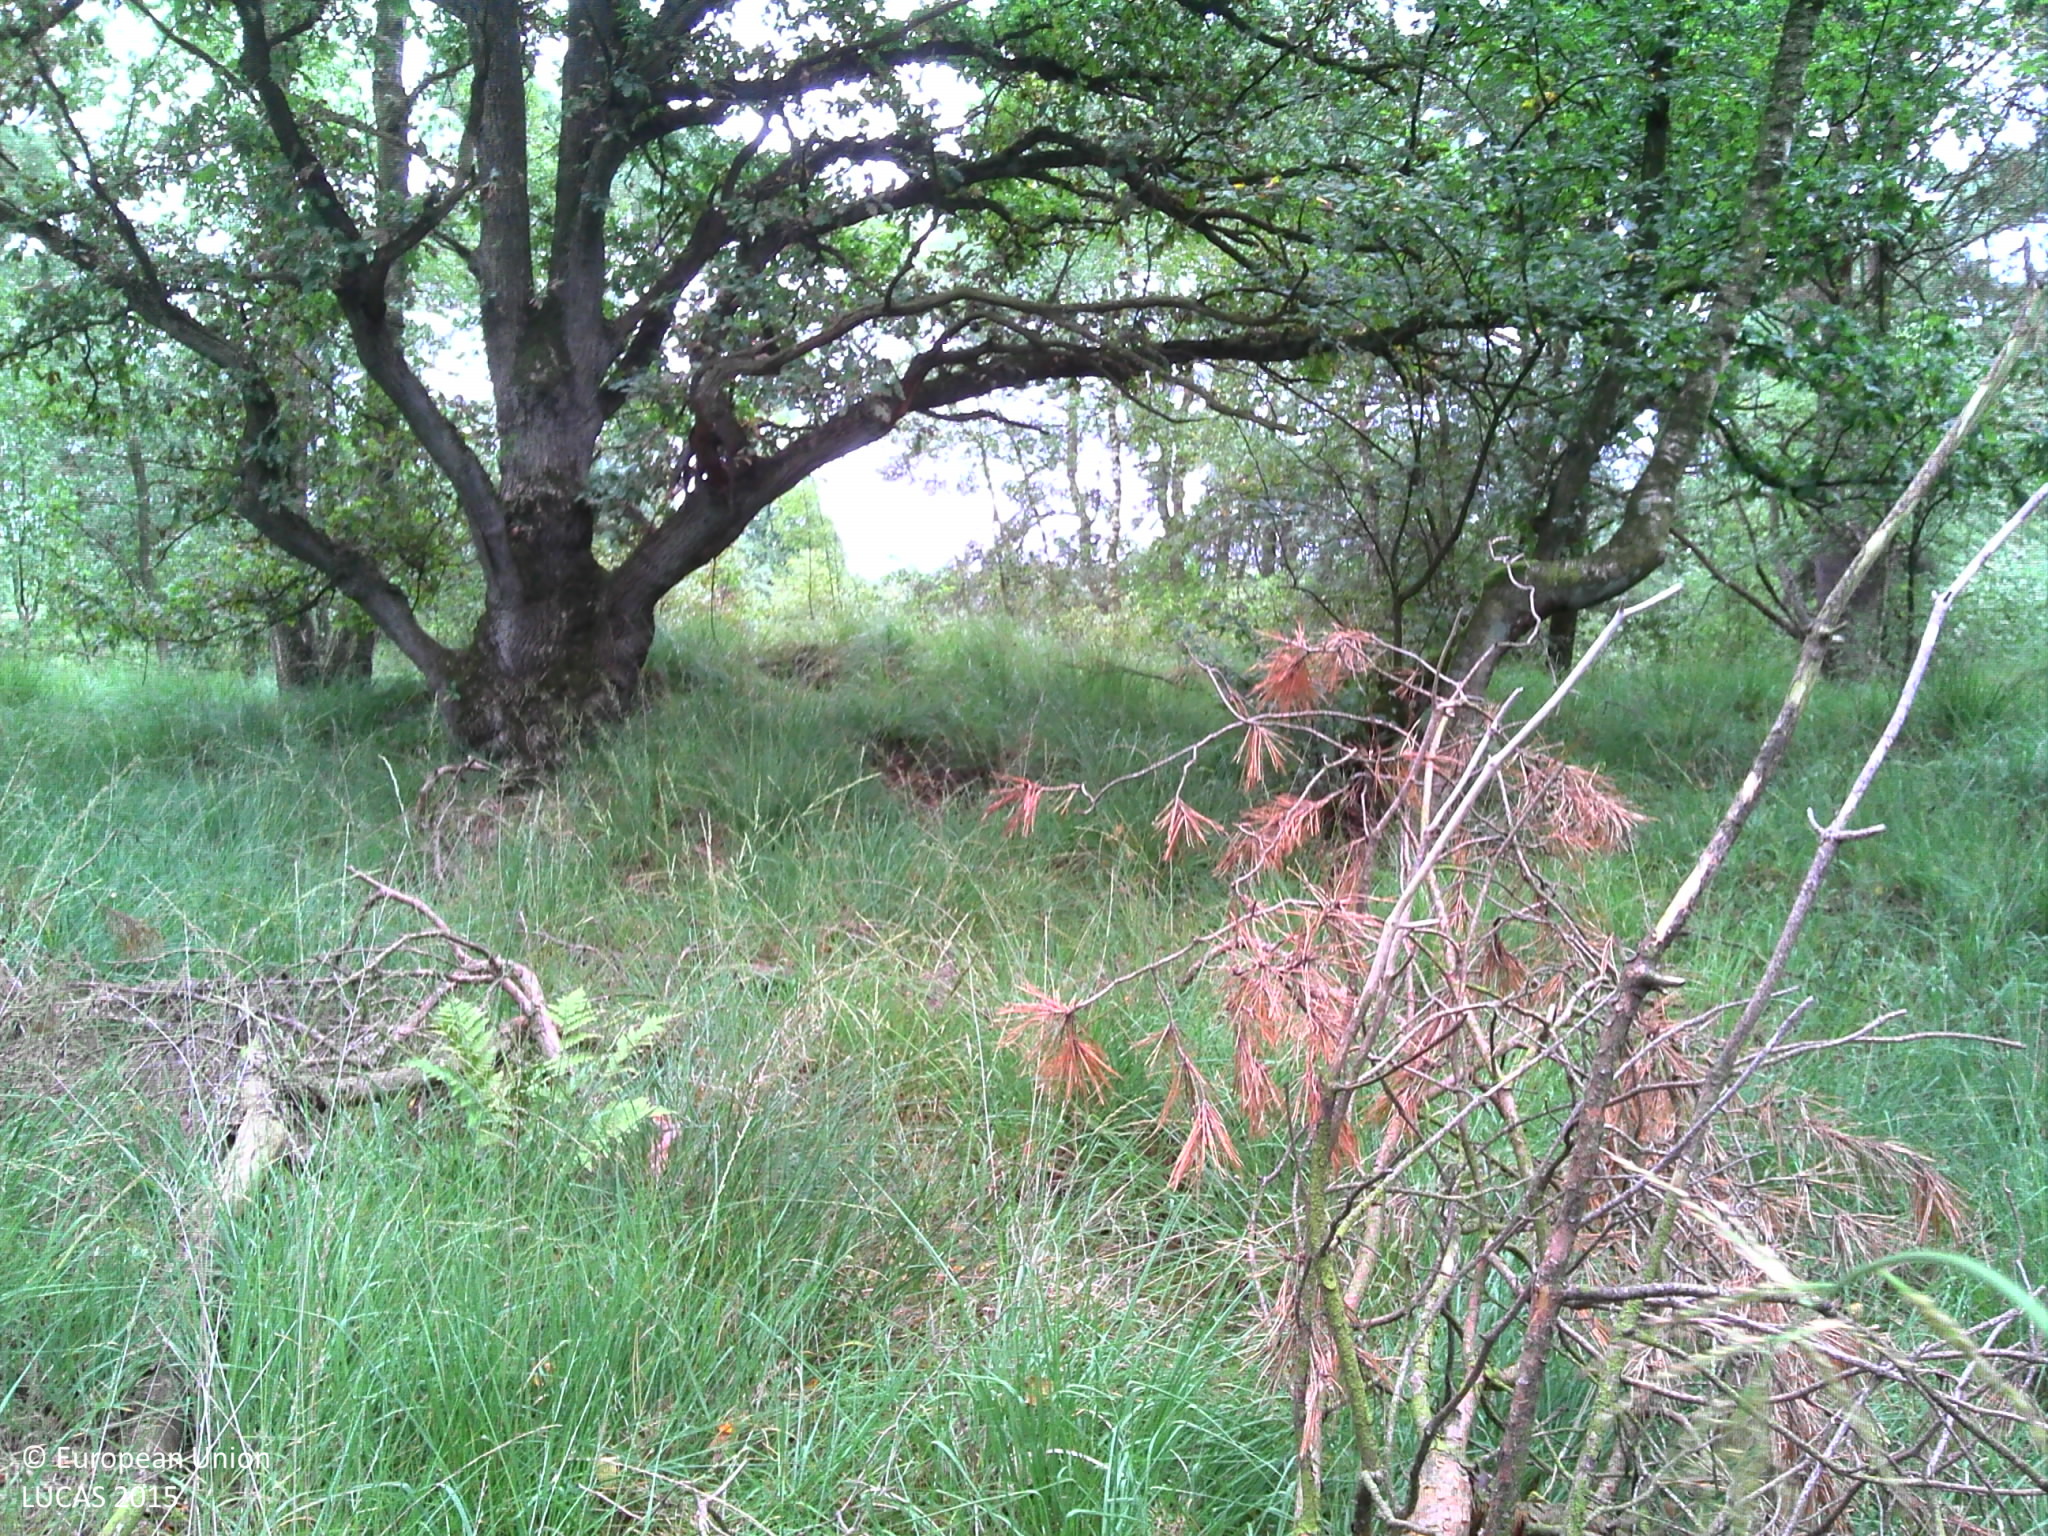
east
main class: Woodland
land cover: Pine dominated mixed woodland
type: acidophilous oak and oak-birch forest
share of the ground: > 75 %
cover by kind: coniferous forest trees 40 %, broadleaved forest trees 35 %, herbaceous plants 25 %
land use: Community services
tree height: > 5 m
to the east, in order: Pine dominated mixed woodland; Tracks; Pine dominated coniferous woodland; Shrubland without tree cover; Tracks; Grassland without tree/shrub cover; Tracks; Broadleaved woodland; Grassland without tree/shrub cover
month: September
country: BE
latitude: 51.3490
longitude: 4.4967
